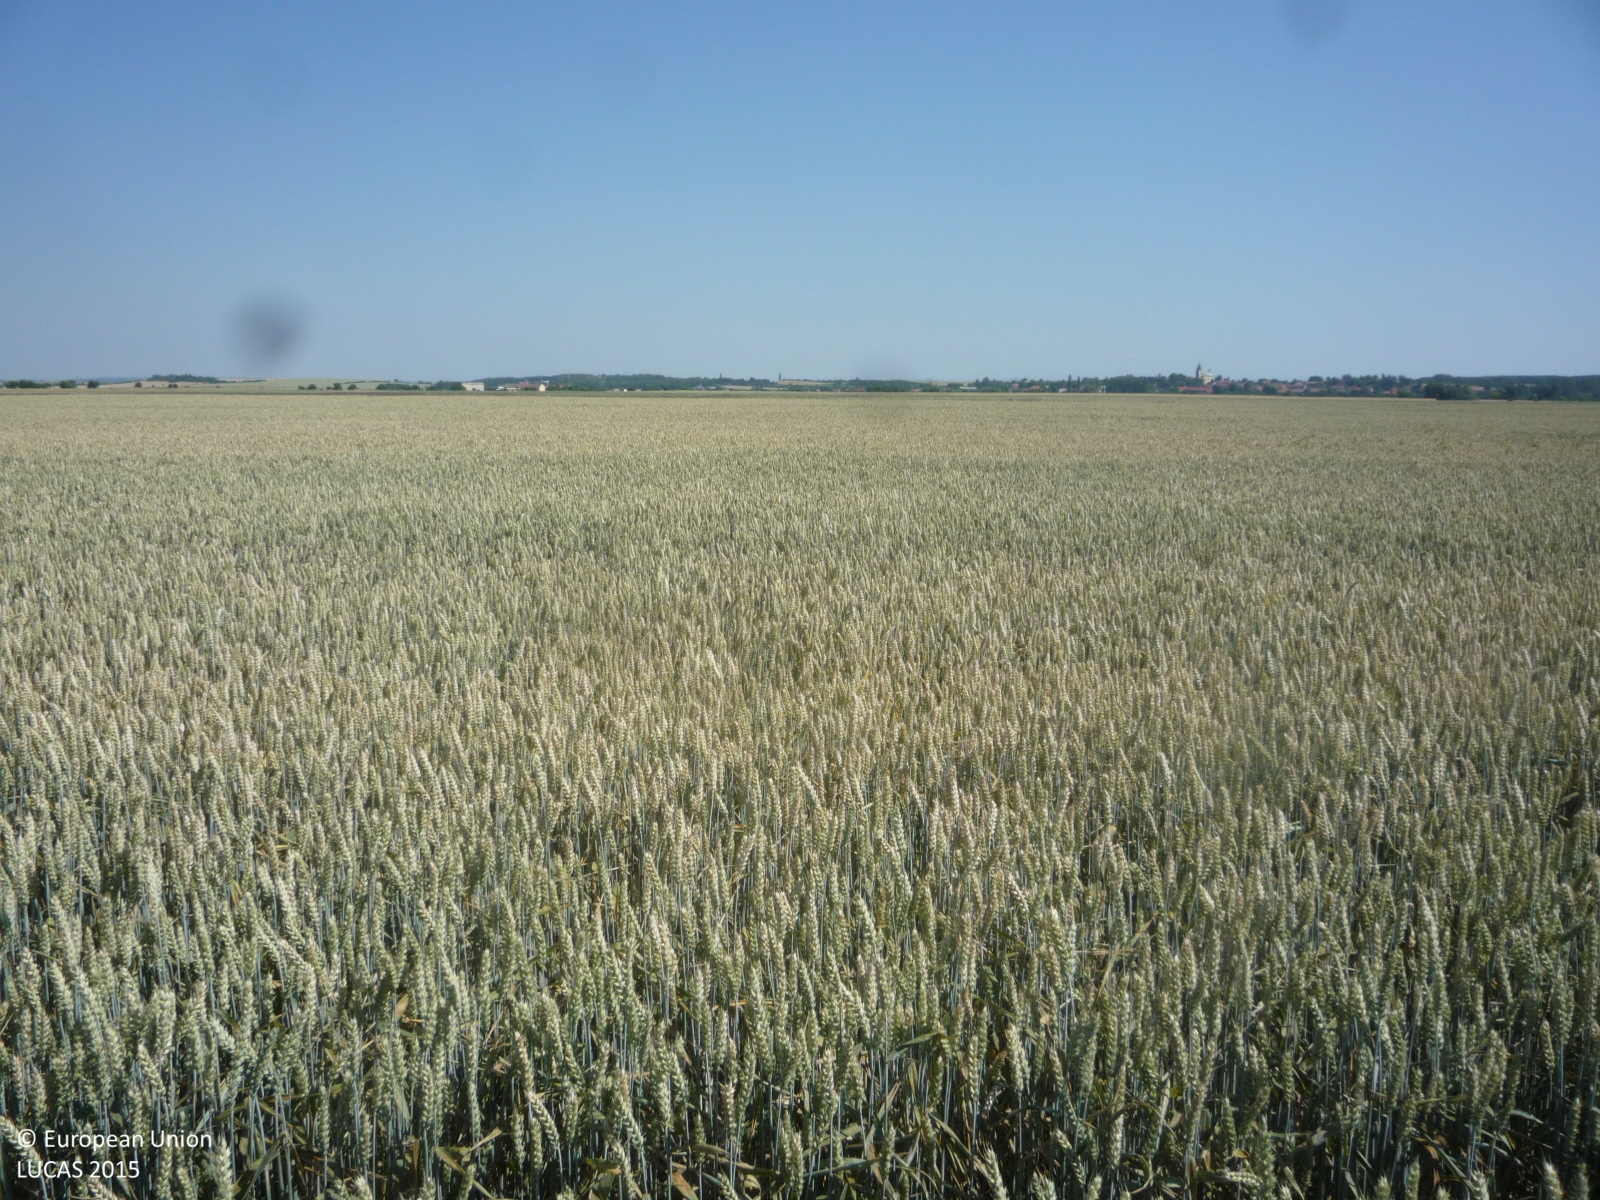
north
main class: Cropland
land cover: Common wheat
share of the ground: > 75 %
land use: Agriculture (excluding fallow land and kitchen gardens)
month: July
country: CZ
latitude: 50.2097
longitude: 15.2019
